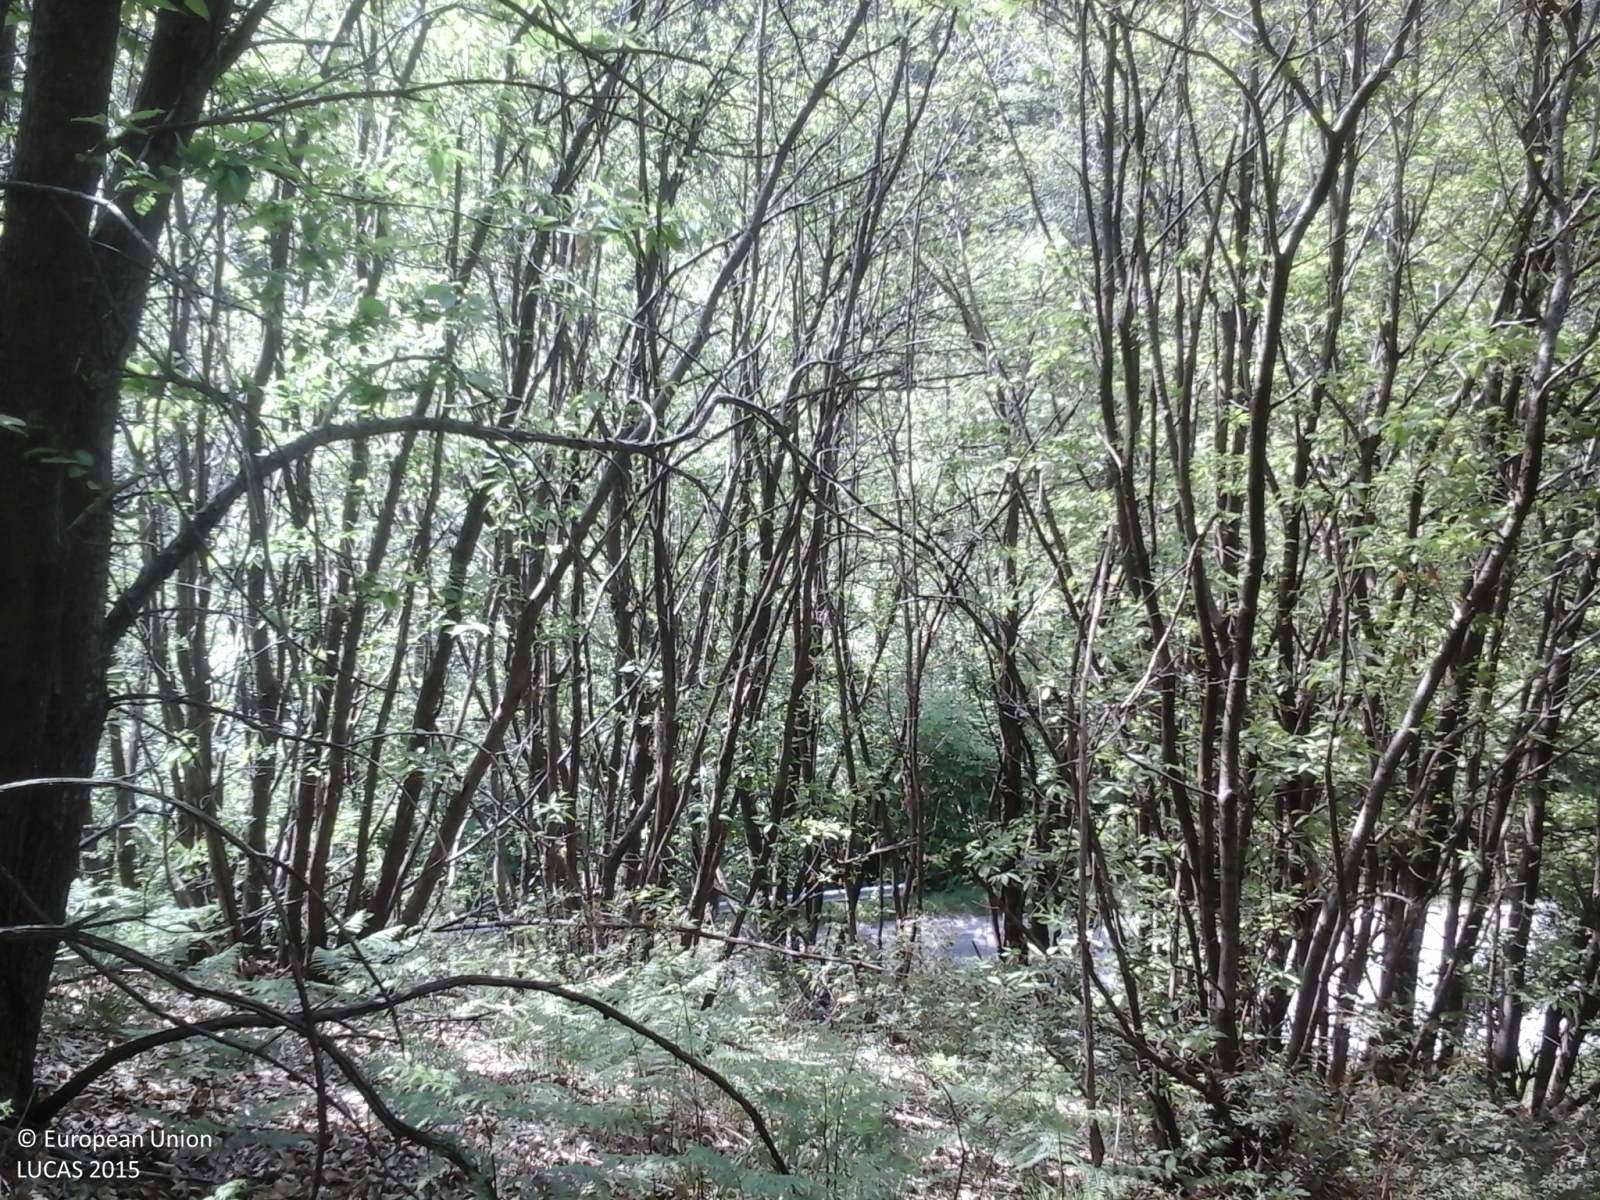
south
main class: Woodland
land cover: Broadleaved woodland
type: thermophilous deciduous forest
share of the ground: > 75 %
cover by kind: broadleaved forest trees 100 %
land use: Forestry
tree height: > 5 m
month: May
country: IT
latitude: 45.7442
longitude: 8.3701
